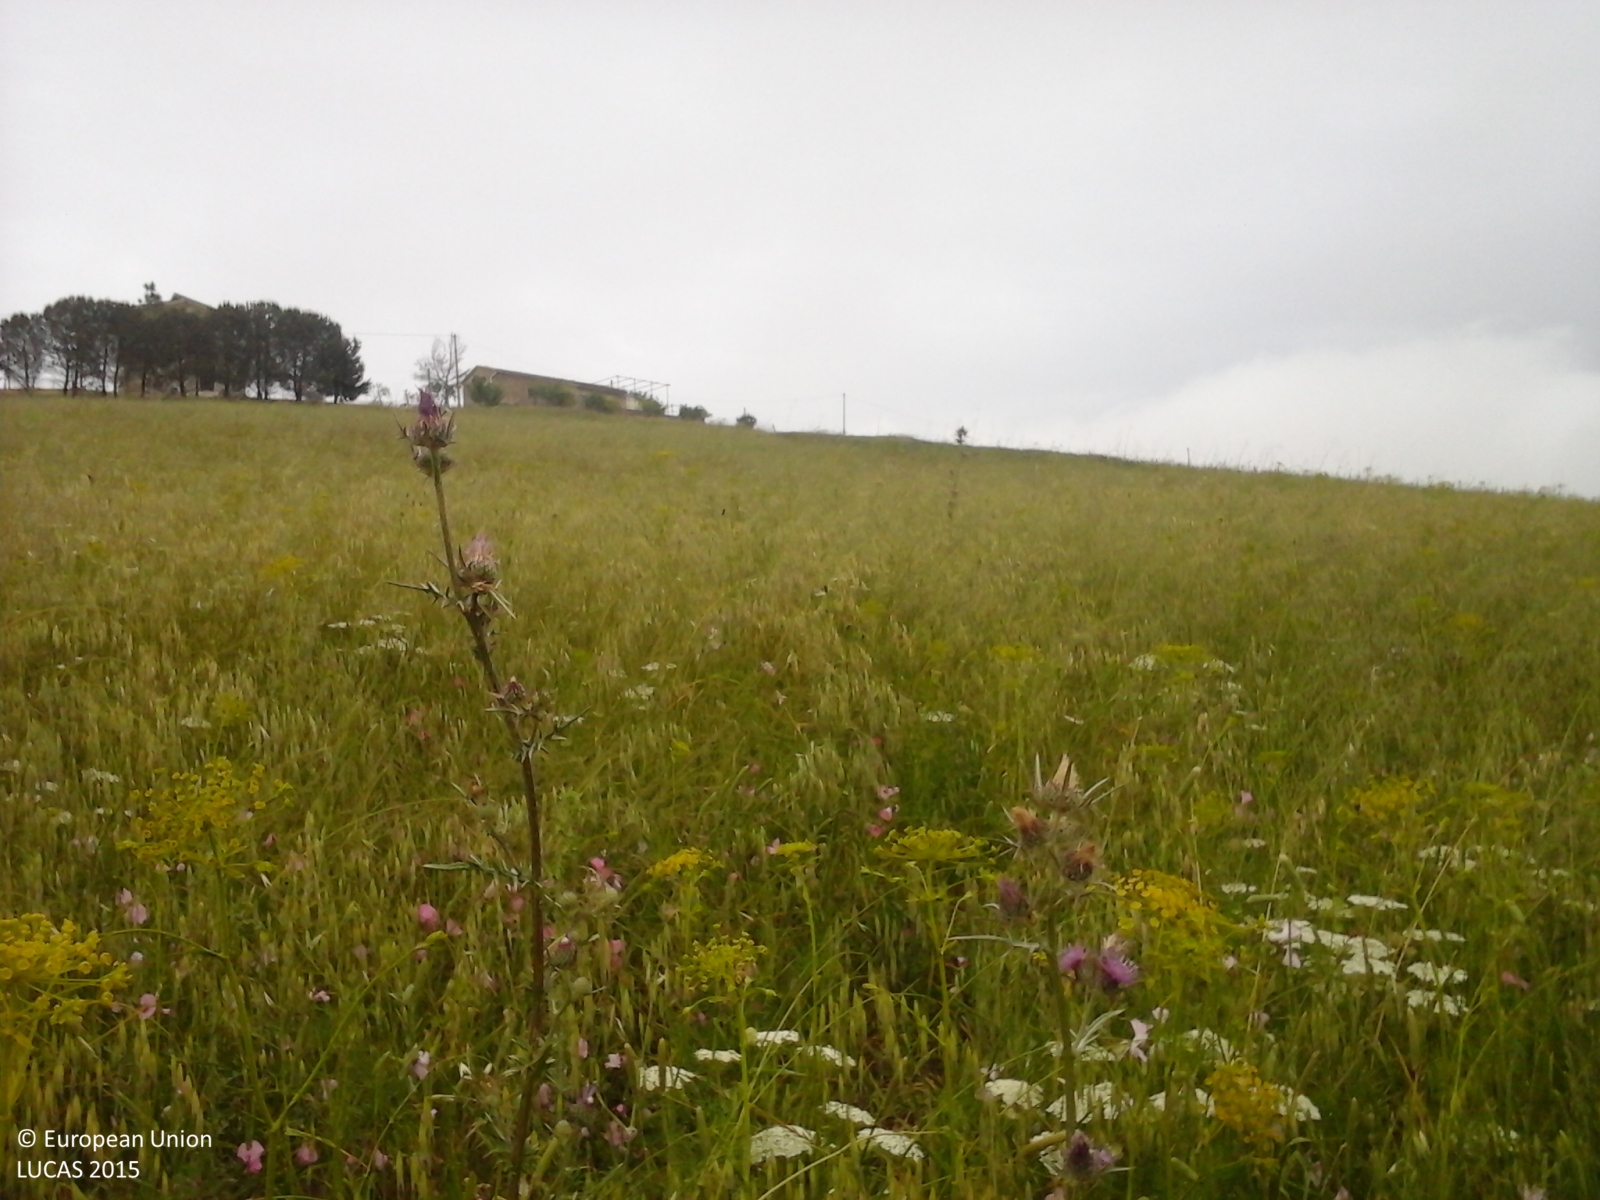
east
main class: Grassland
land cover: Spontaneously vegetated surfaces
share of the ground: > 75 %
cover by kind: herbaceous plants 100 %
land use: Fallow land
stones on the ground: < 10 %
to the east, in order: Spontaneously vegetated surfaces; Temporary grasslands; Fences; Other fruit trees and berries; Artificial constructions in urban areas; Grassland without tree/shrub cover; Oats
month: May
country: IT
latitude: 37.7561
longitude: 13.9554
